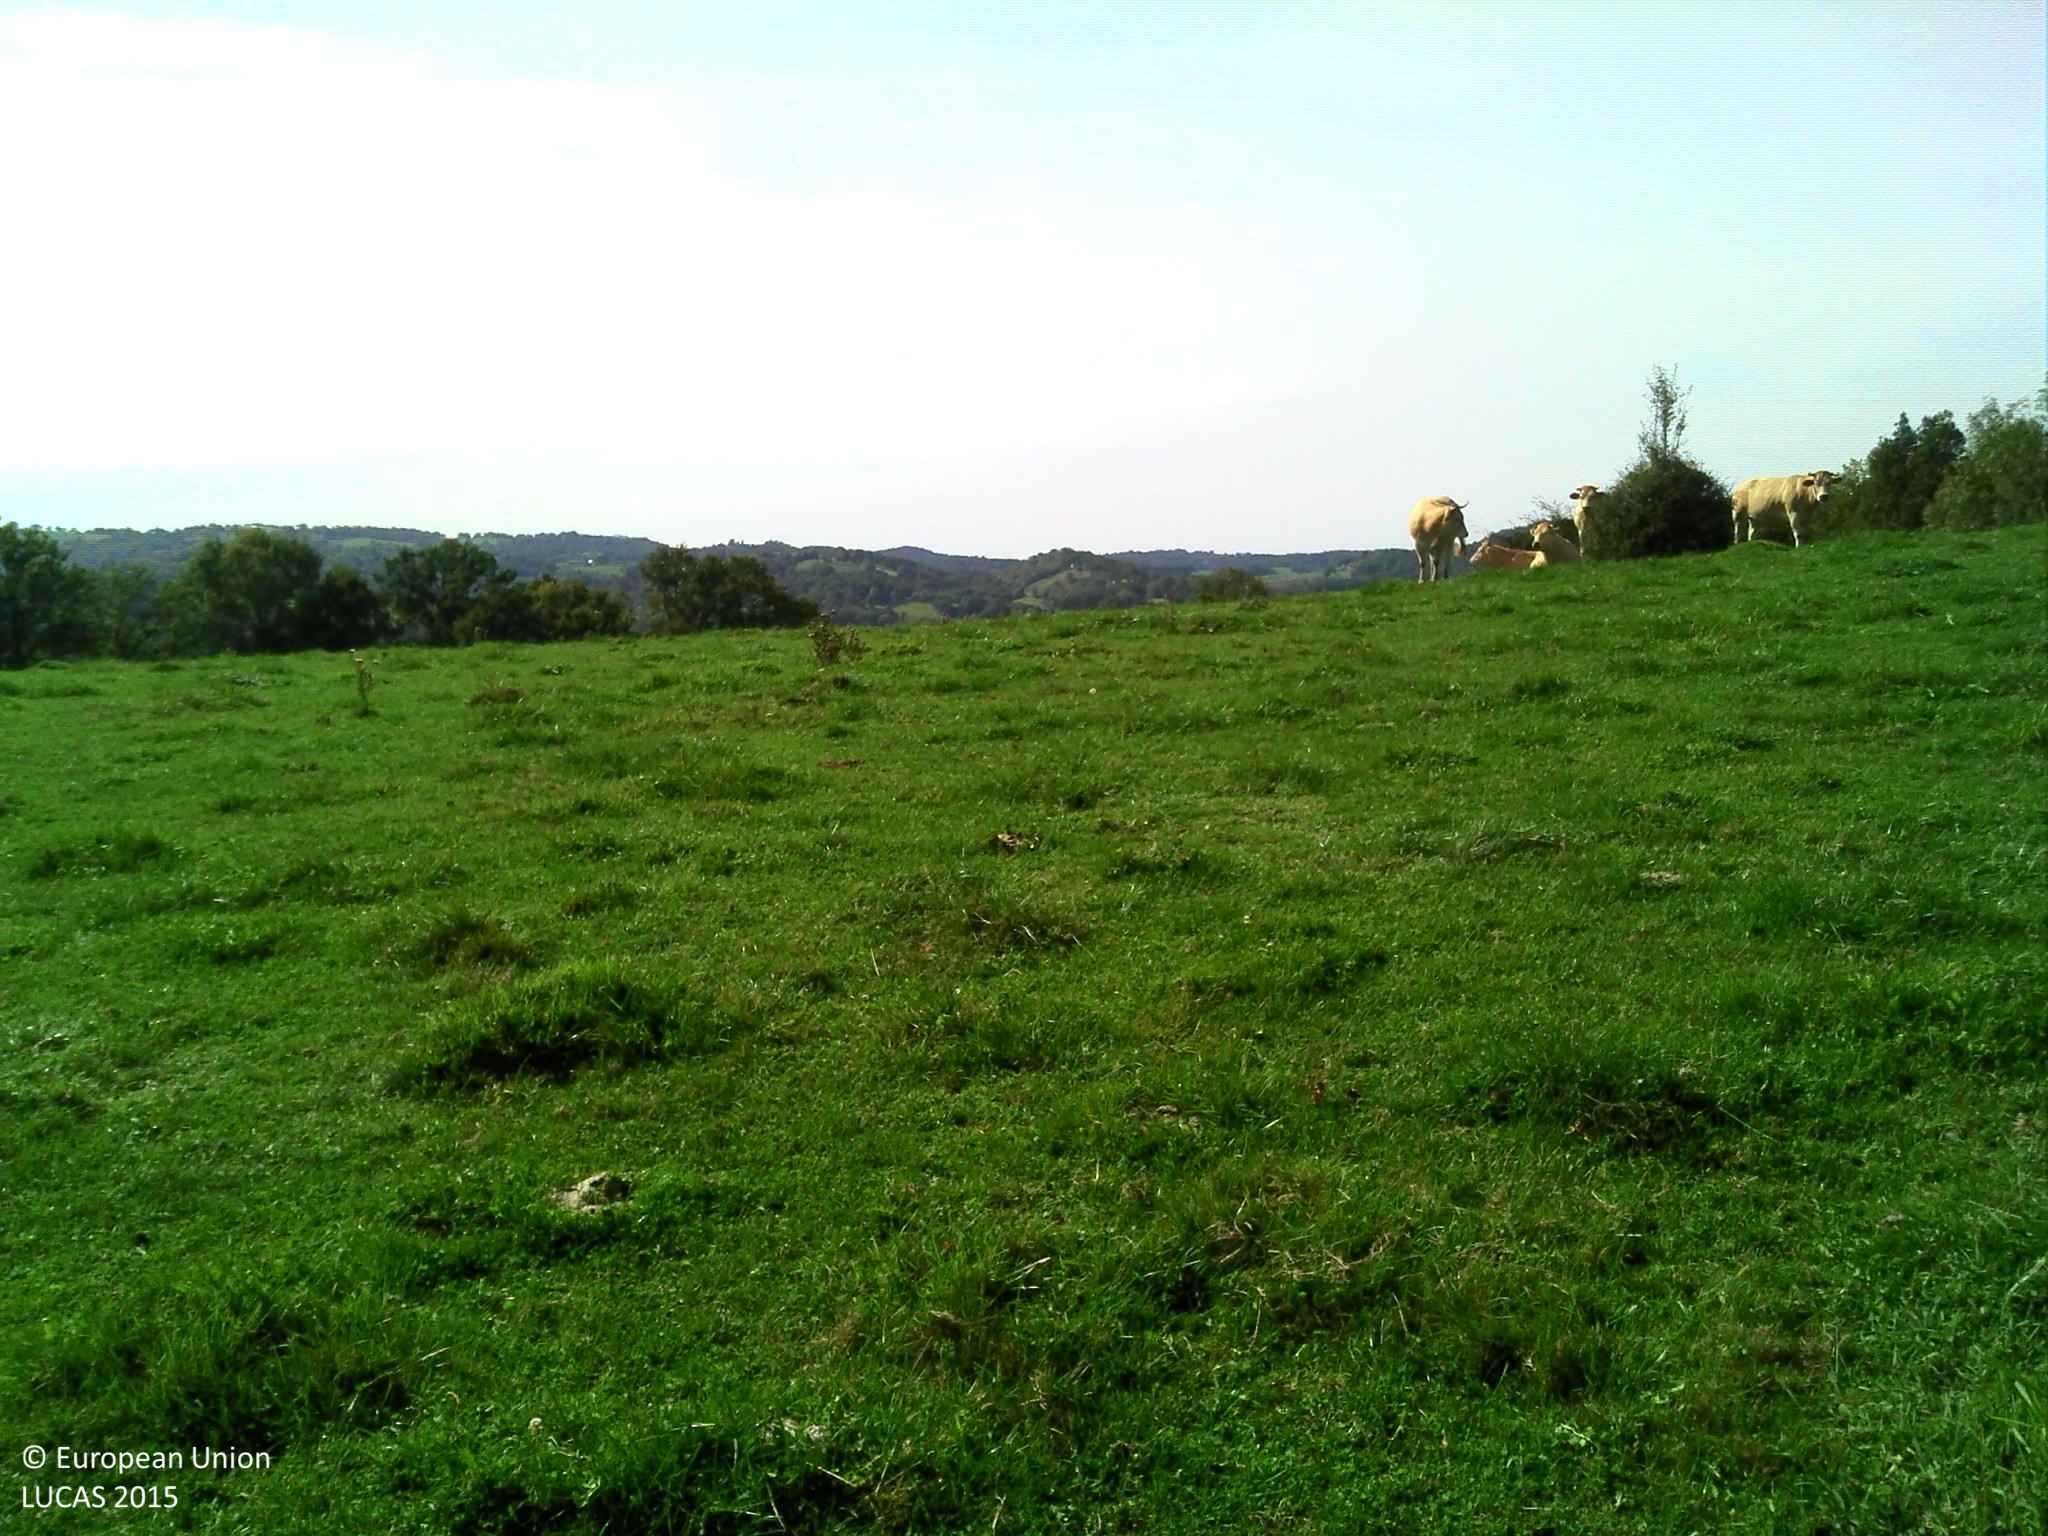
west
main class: Grassland
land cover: Grassland without tree/shrub cover
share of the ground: > 75 %
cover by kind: herbaceous plants 100 %
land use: Agriculture (excluding fallow land and kitchen gardens)
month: September
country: FR
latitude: 43.2207
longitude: -0.4589
